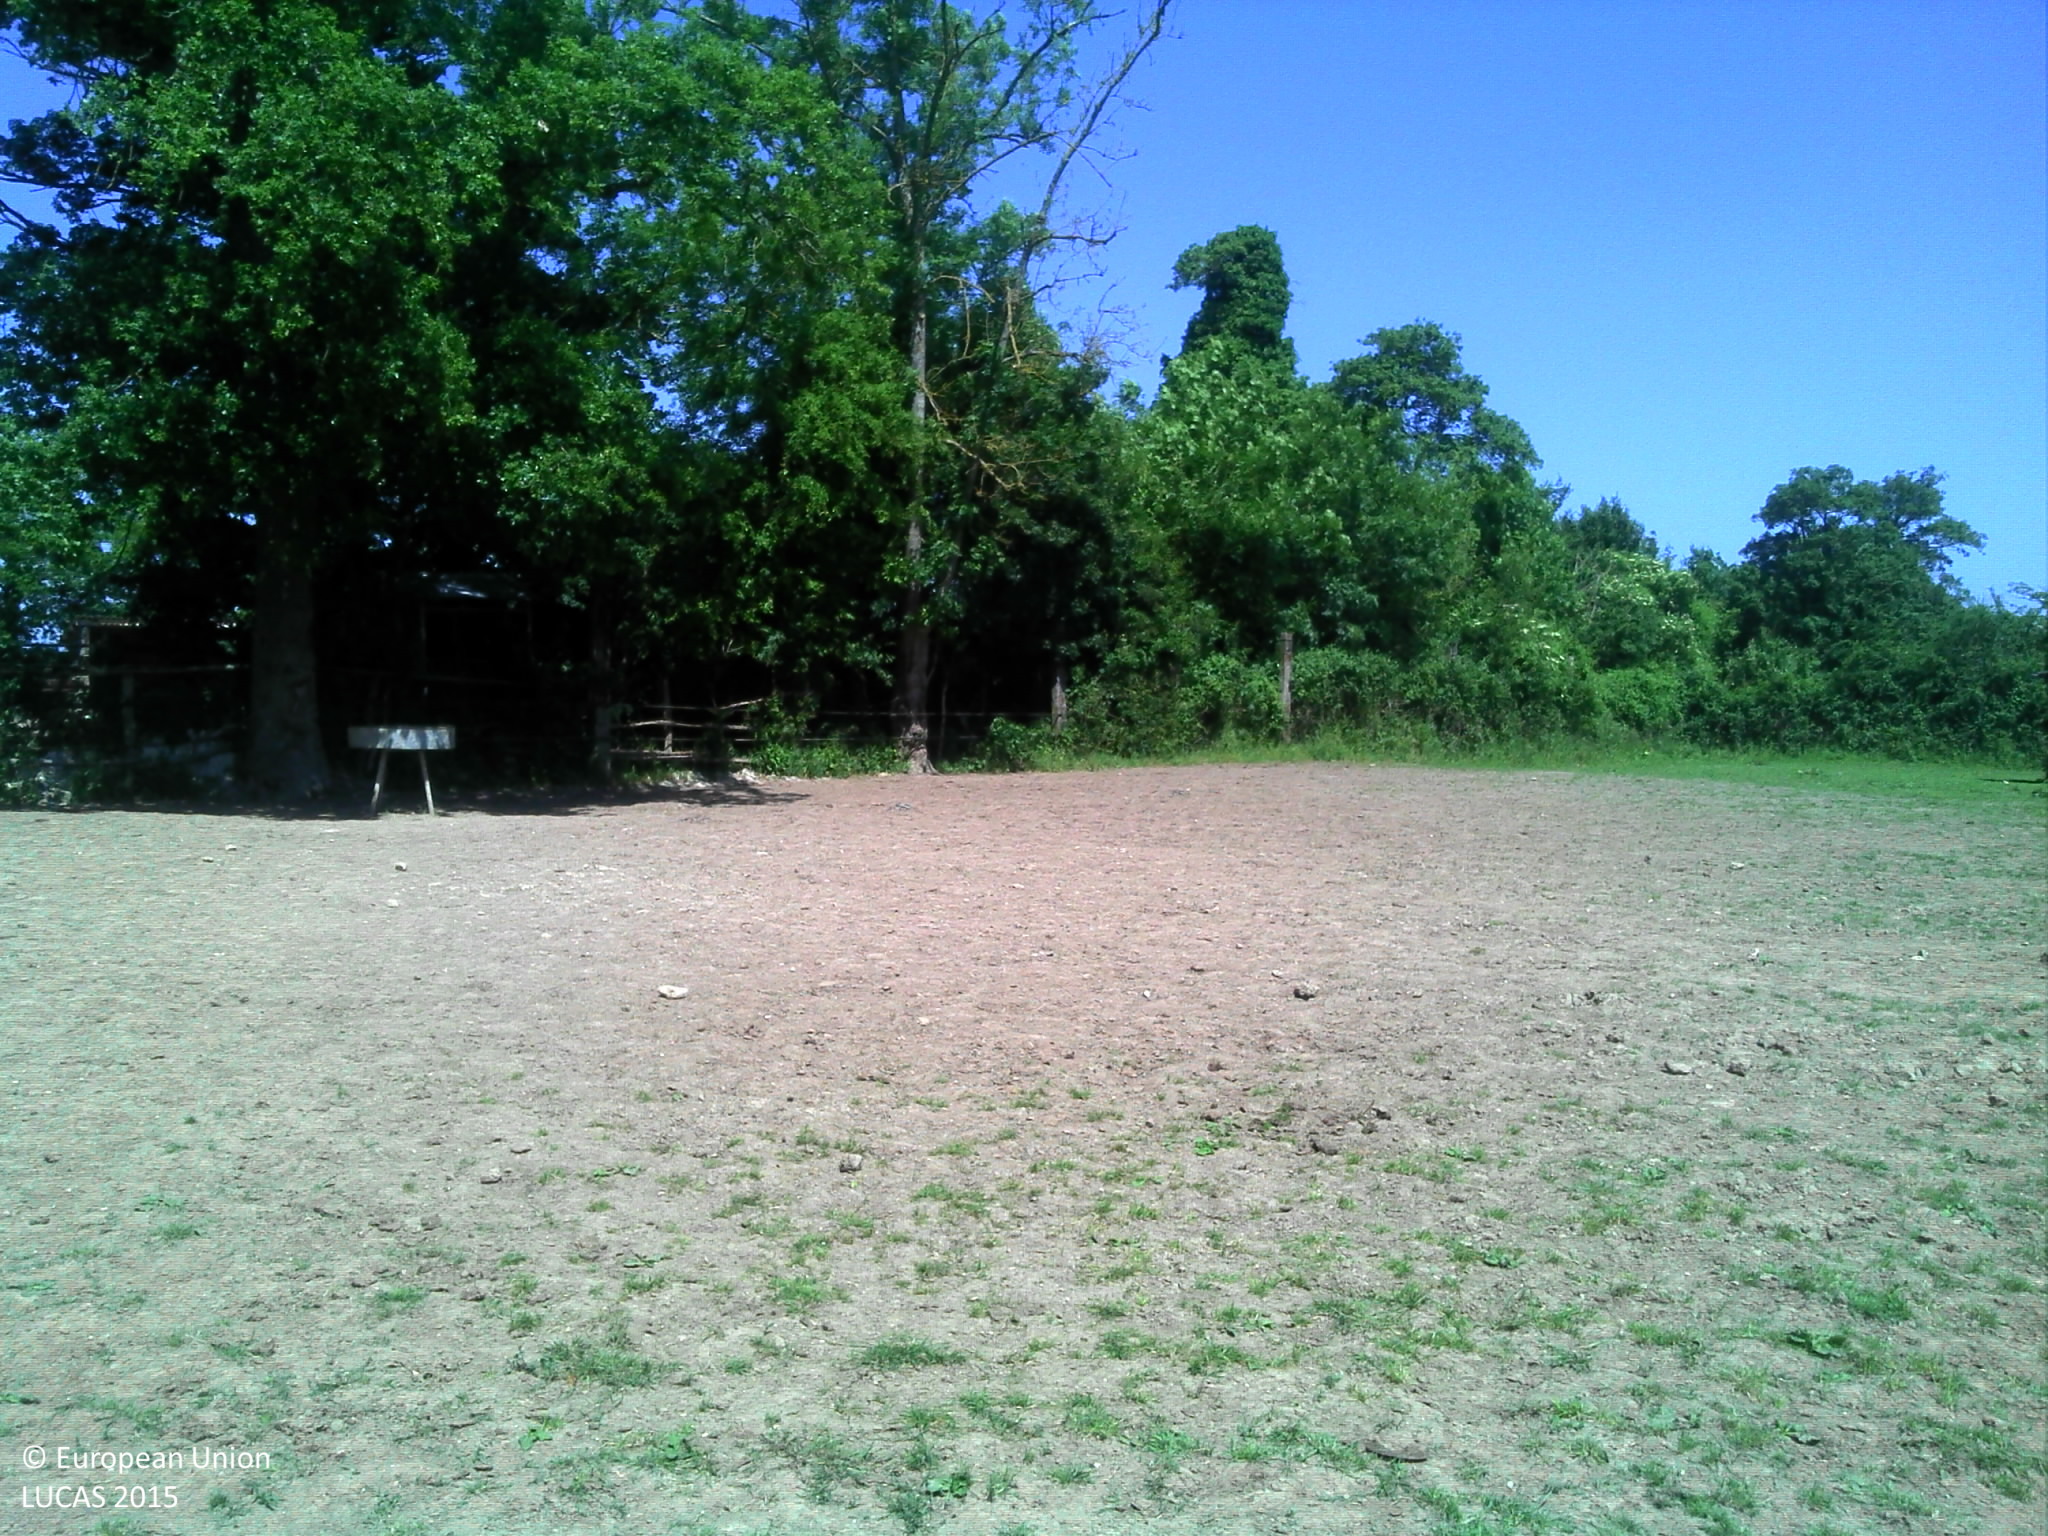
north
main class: Grassland
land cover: Grassland without tree/shrub cover
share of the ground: 50 - 75 %
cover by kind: herbaceous plants 85 %, unconsolidated bare surface 15 %
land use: Agriculture (excluding fallow land and kitchen gardens)
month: June
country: FR
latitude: 48.7589
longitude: 0.1360
